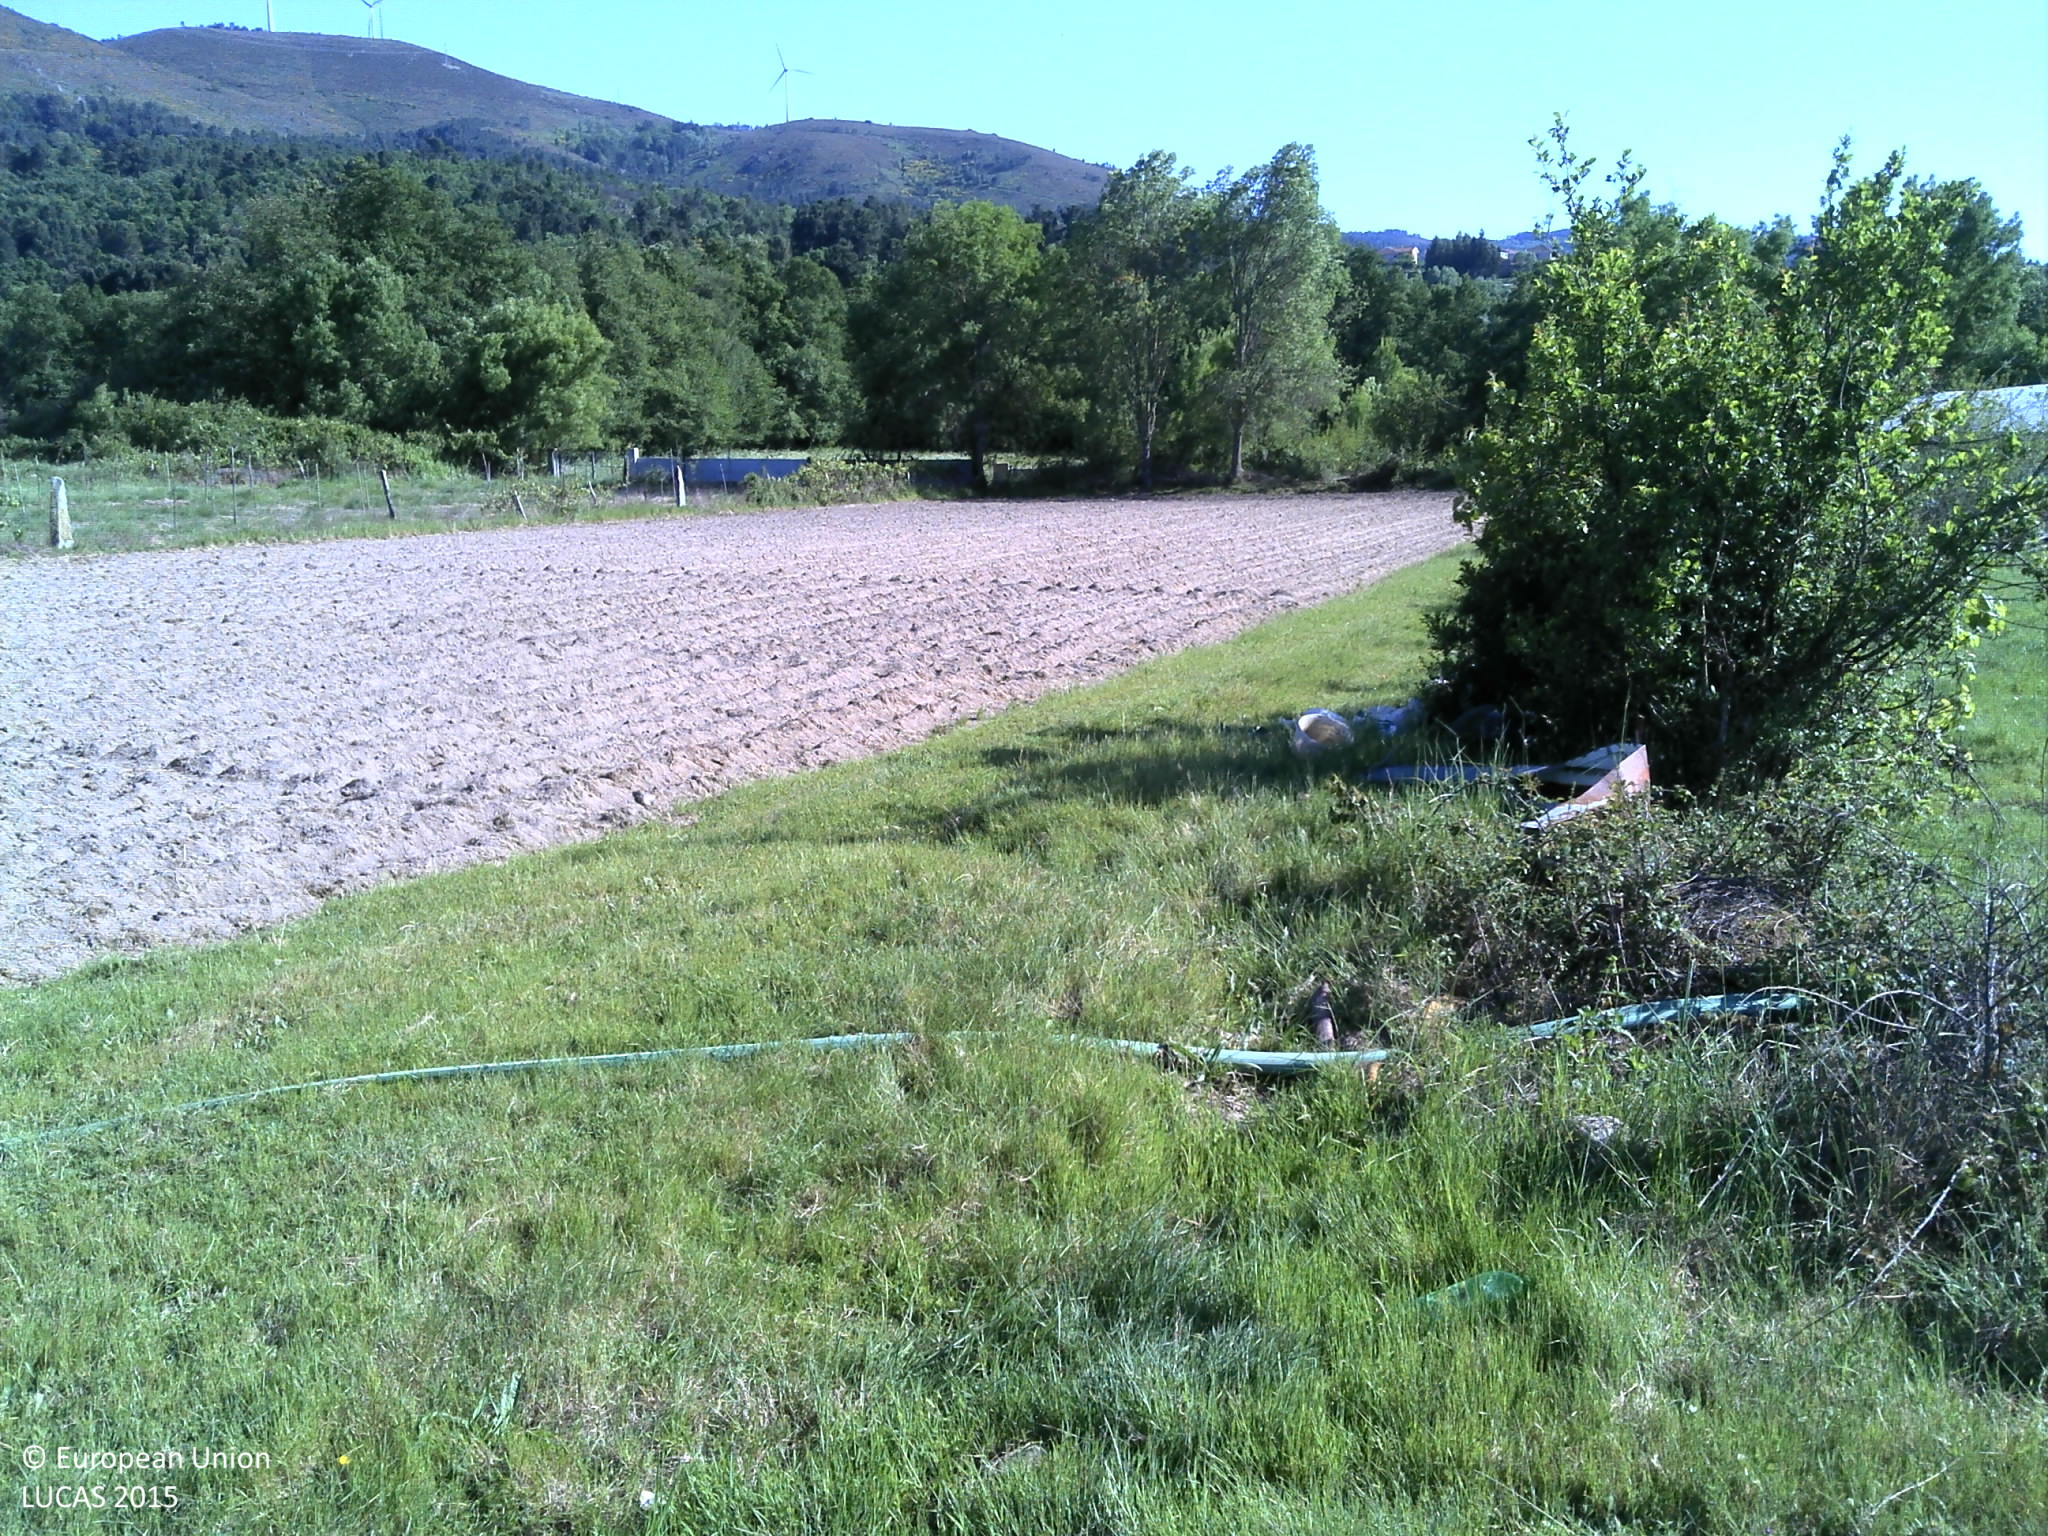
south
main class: Grassland
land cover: Grassland without tree/shrub cover
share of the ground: > 75 %
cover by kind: herbaceous plants 80 %, unconsolidated bare surface 15 %, shrubs 5 %
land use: Agriculture (excluding fallow land and kitchen gardens)
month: May
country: PT
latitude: 41.5636
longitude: -7.5775
